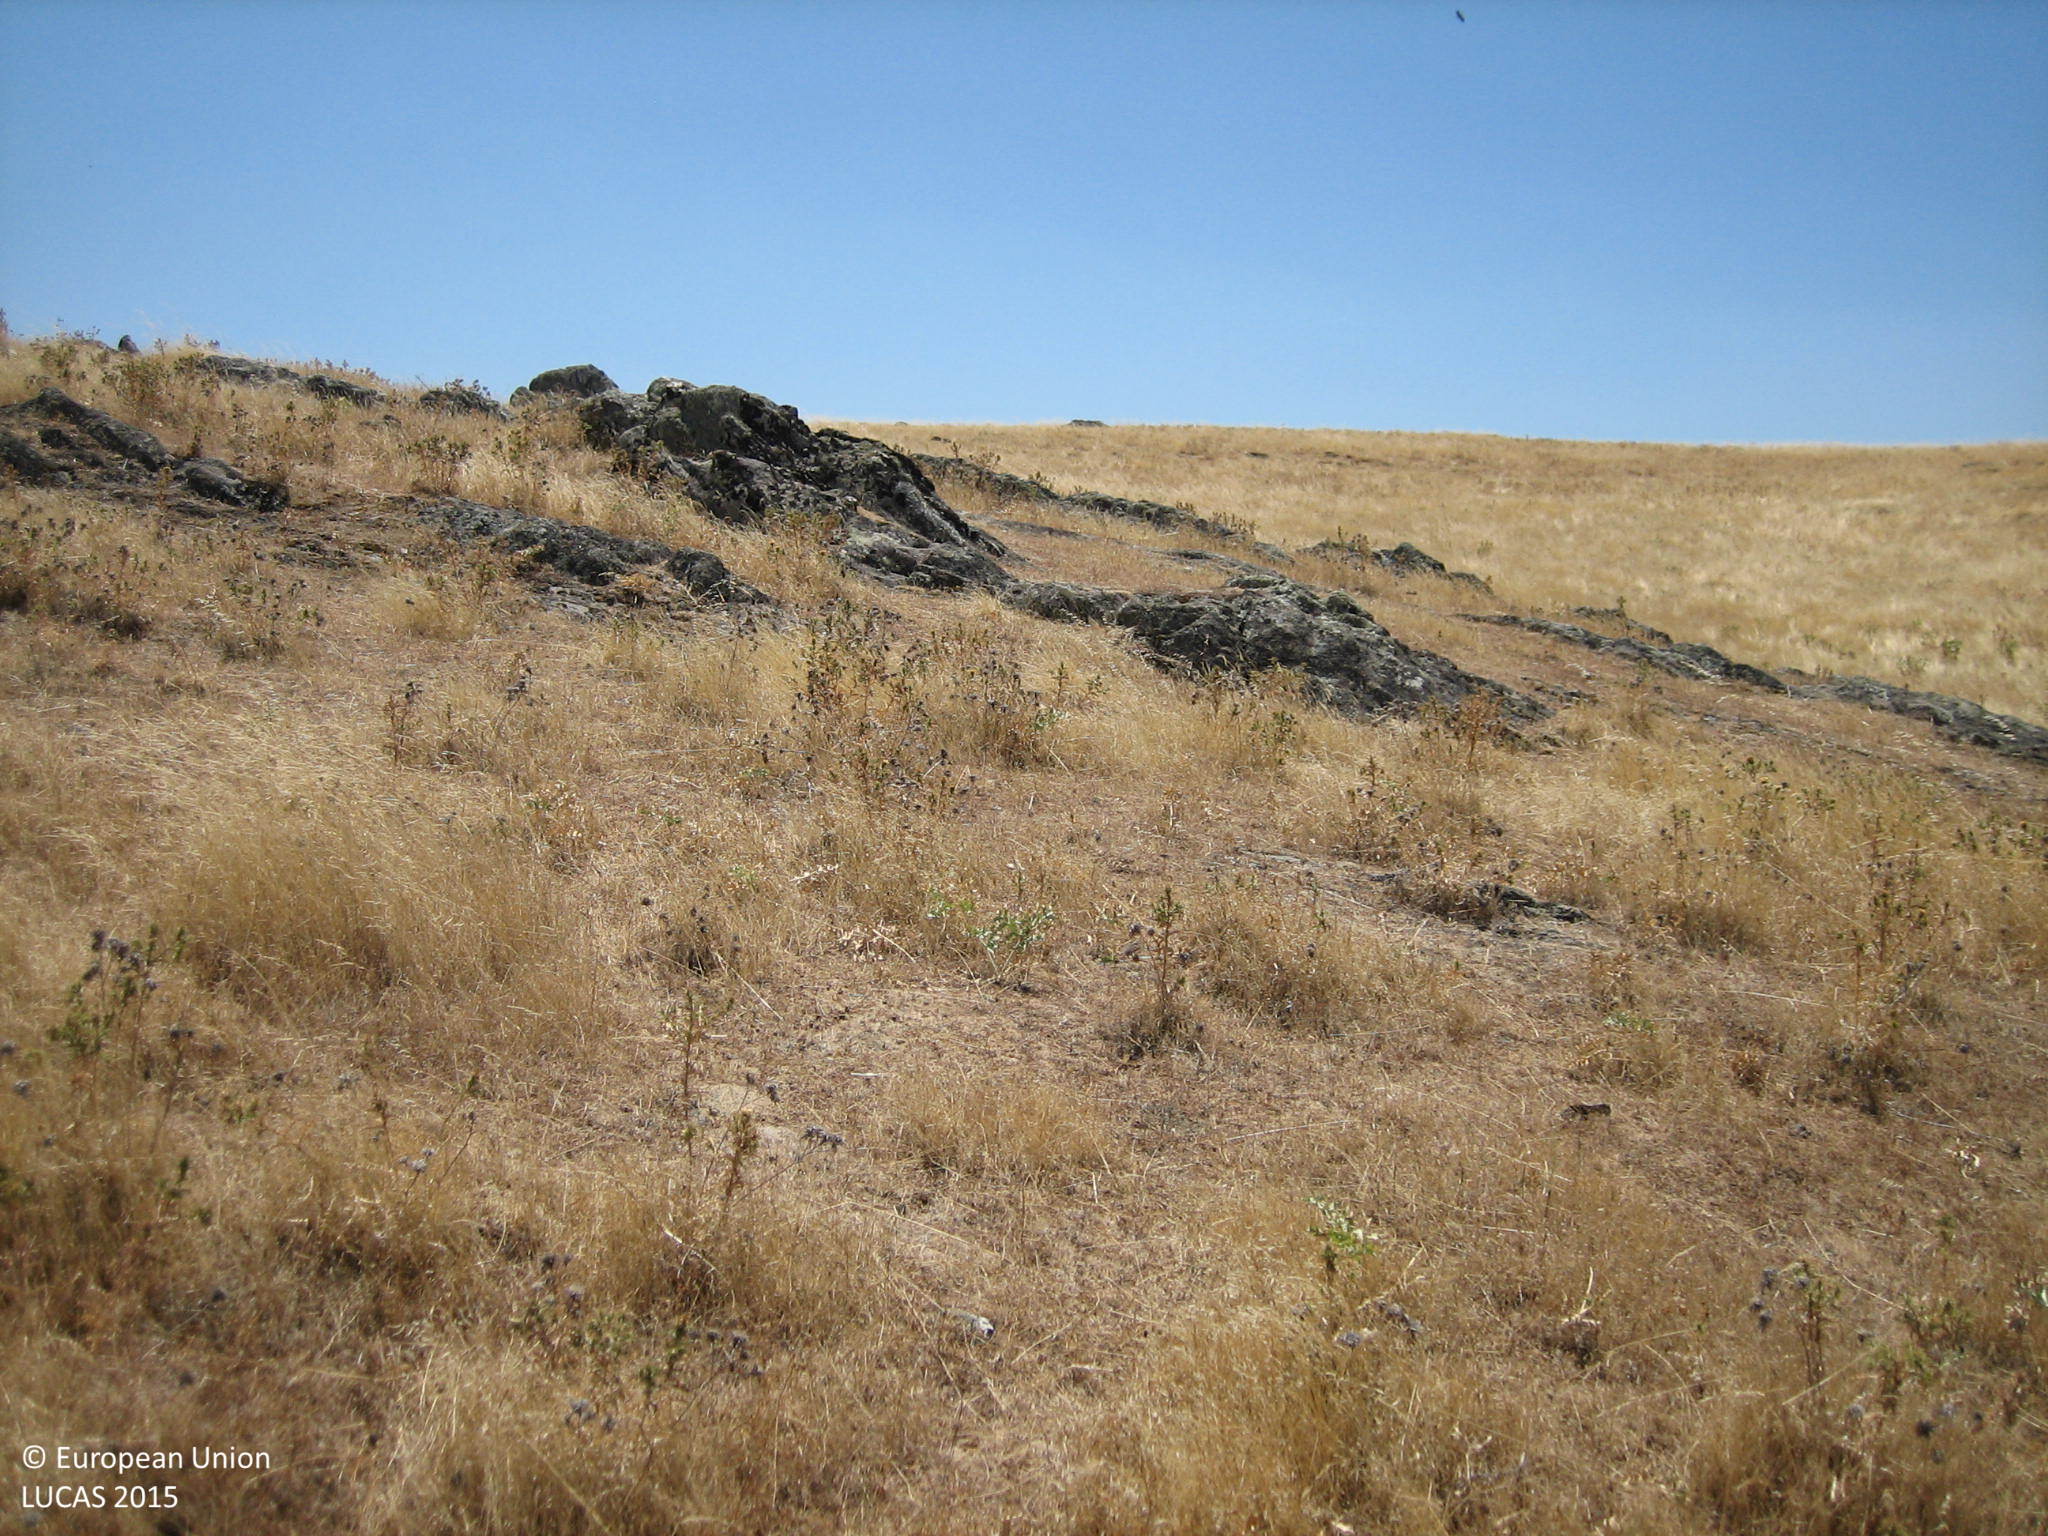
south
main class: Grassland
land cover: Grassland without tree/shrub cover
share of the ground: > 75 %
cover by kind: herbaceous plants 100 %
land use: Agriculture (excluding fallow land and kitchen gardens)
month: July
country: ES
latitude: 38.1989
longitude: -6.2698
